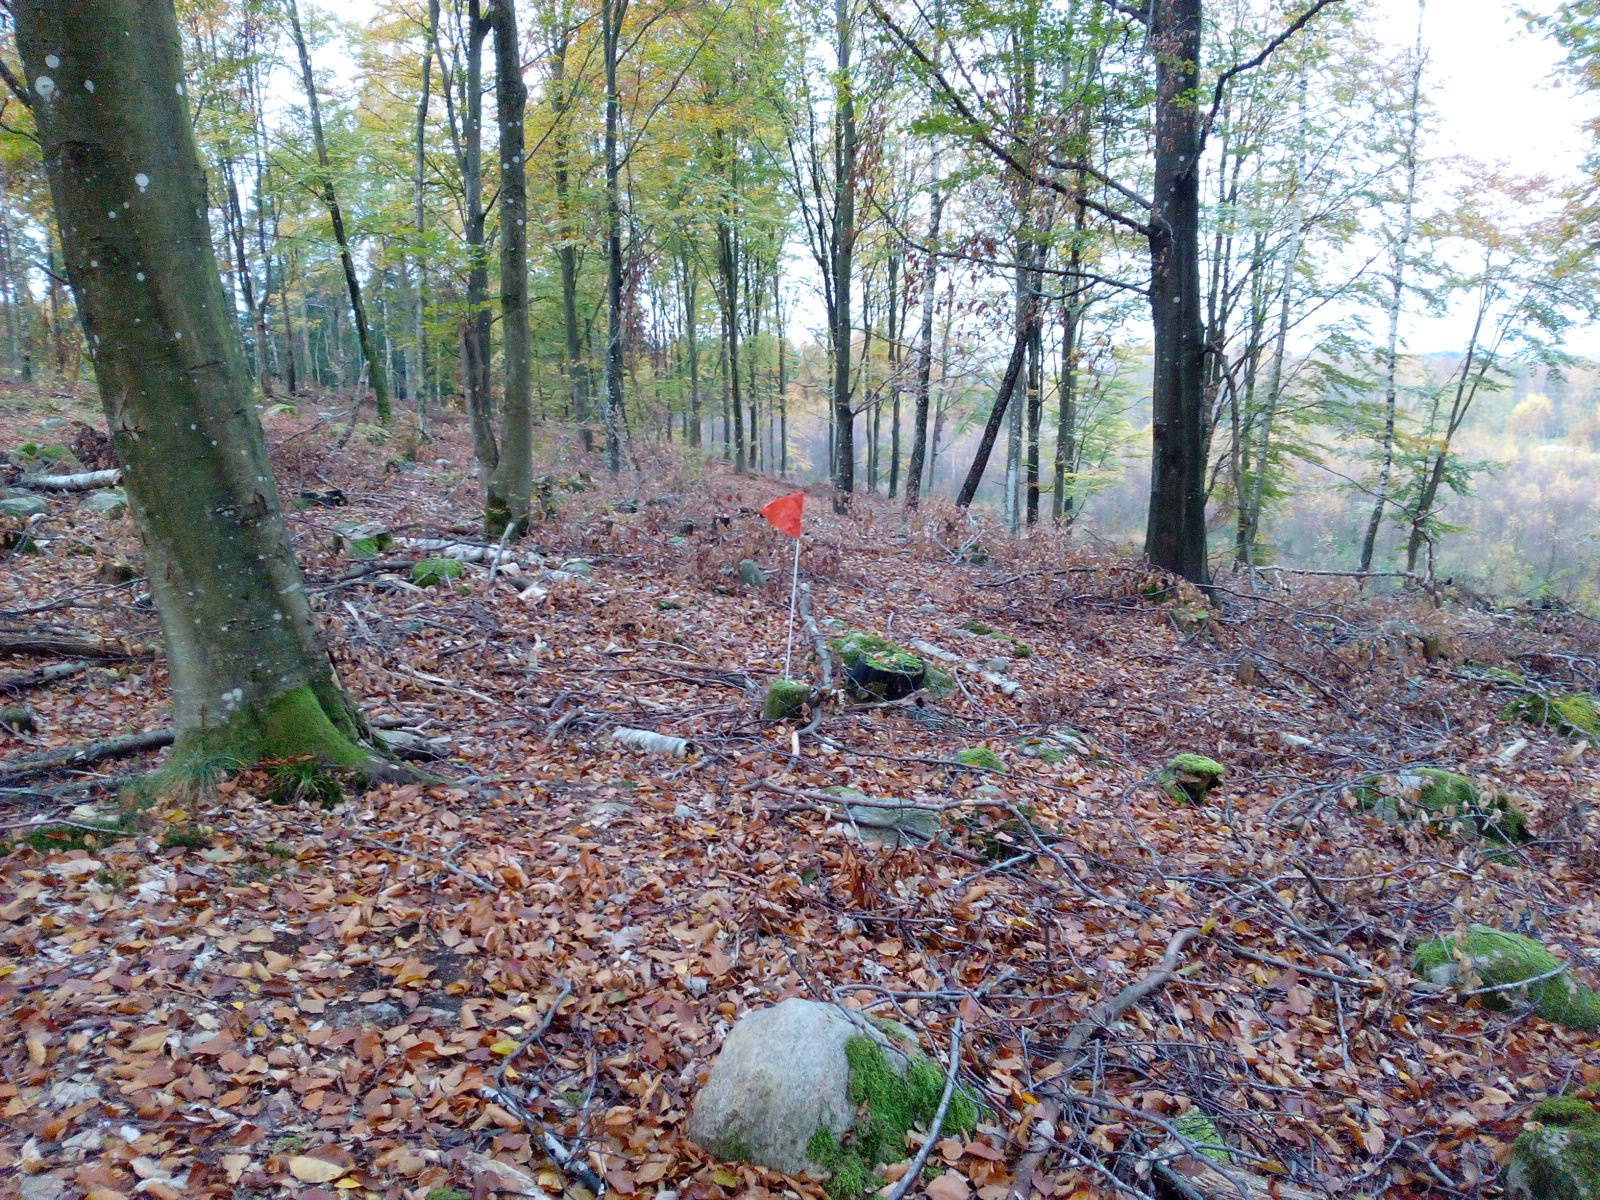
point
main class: Woodland
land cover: Broadleaved woodland
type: beech forest
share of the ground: 50 - 75 %
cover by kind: broadleaved forest trees 60 %, herbaceous plants 40 %
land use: Forestry
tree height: > 5 m
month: October
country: SE
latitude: 56.5086
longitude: 13.1655
